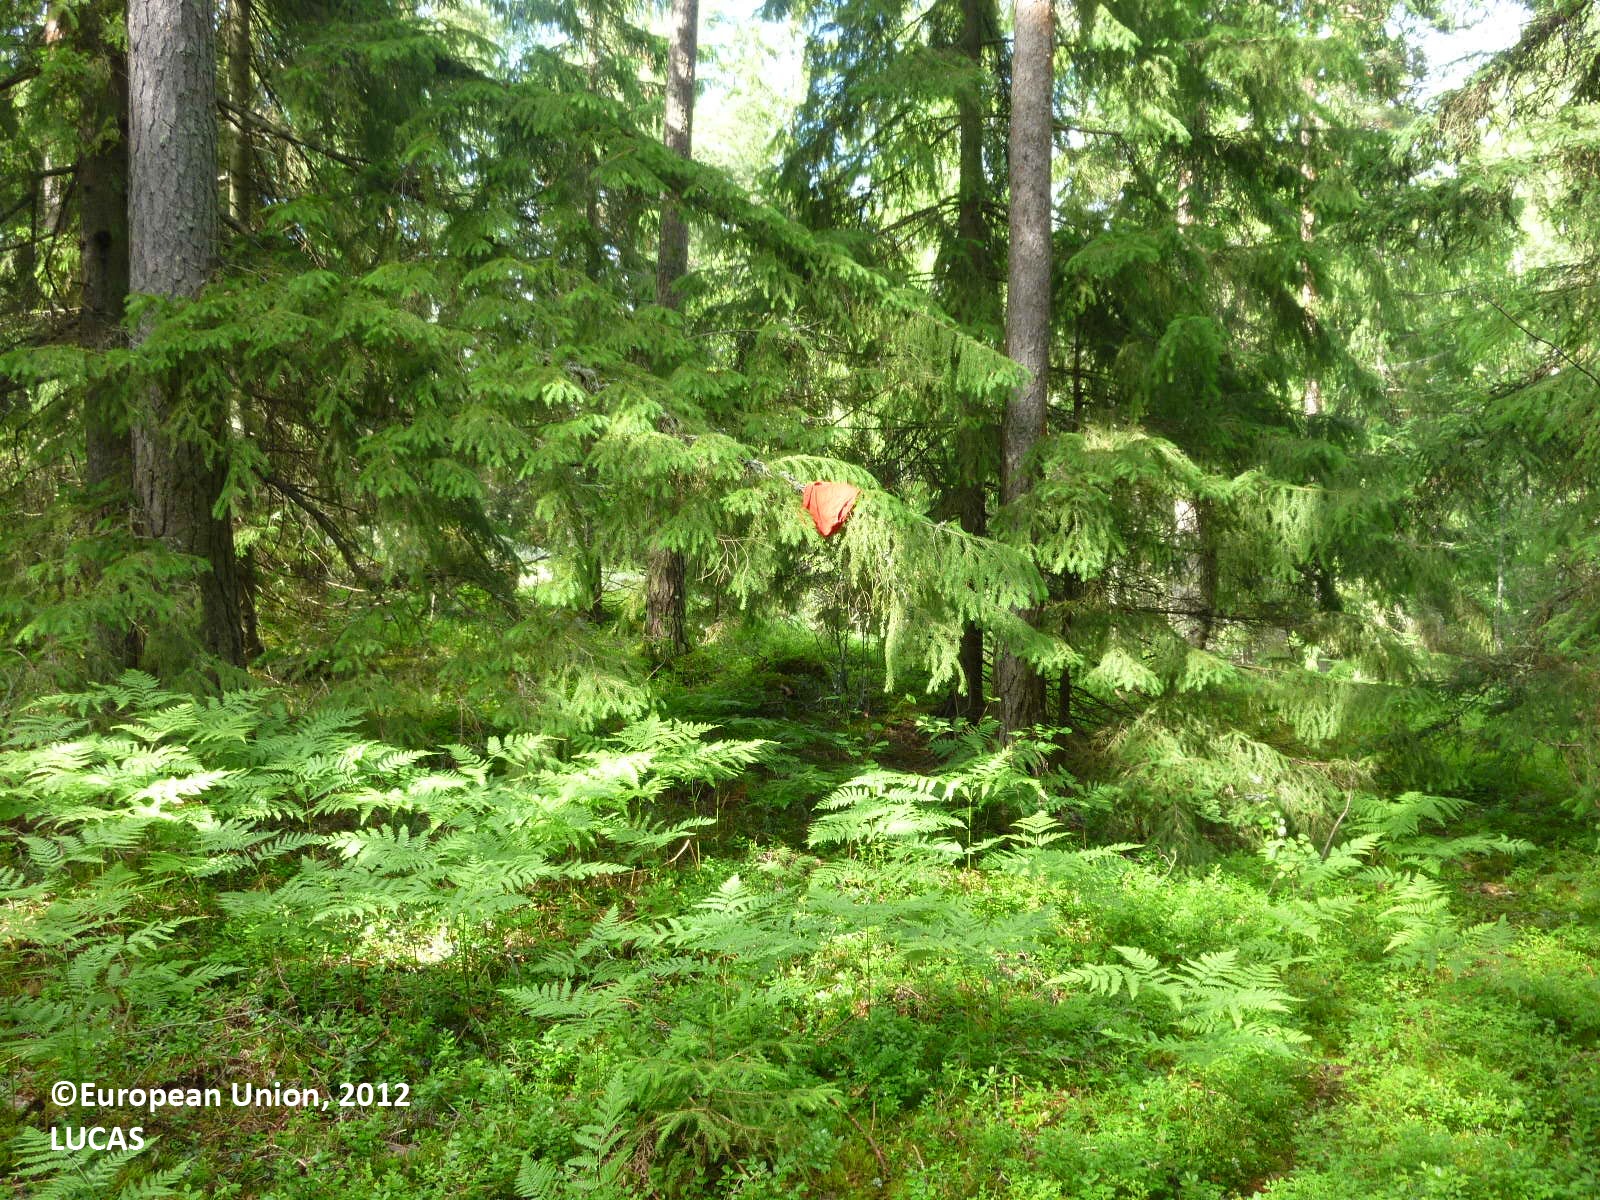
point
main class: Woodland
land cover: Spruce dominated coniferous woodland
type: boreal forest
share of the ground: 50 - 75 %
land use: Forestry
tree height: > 5 m
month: June
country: FI
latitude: 60.2671
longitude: 22.6366
